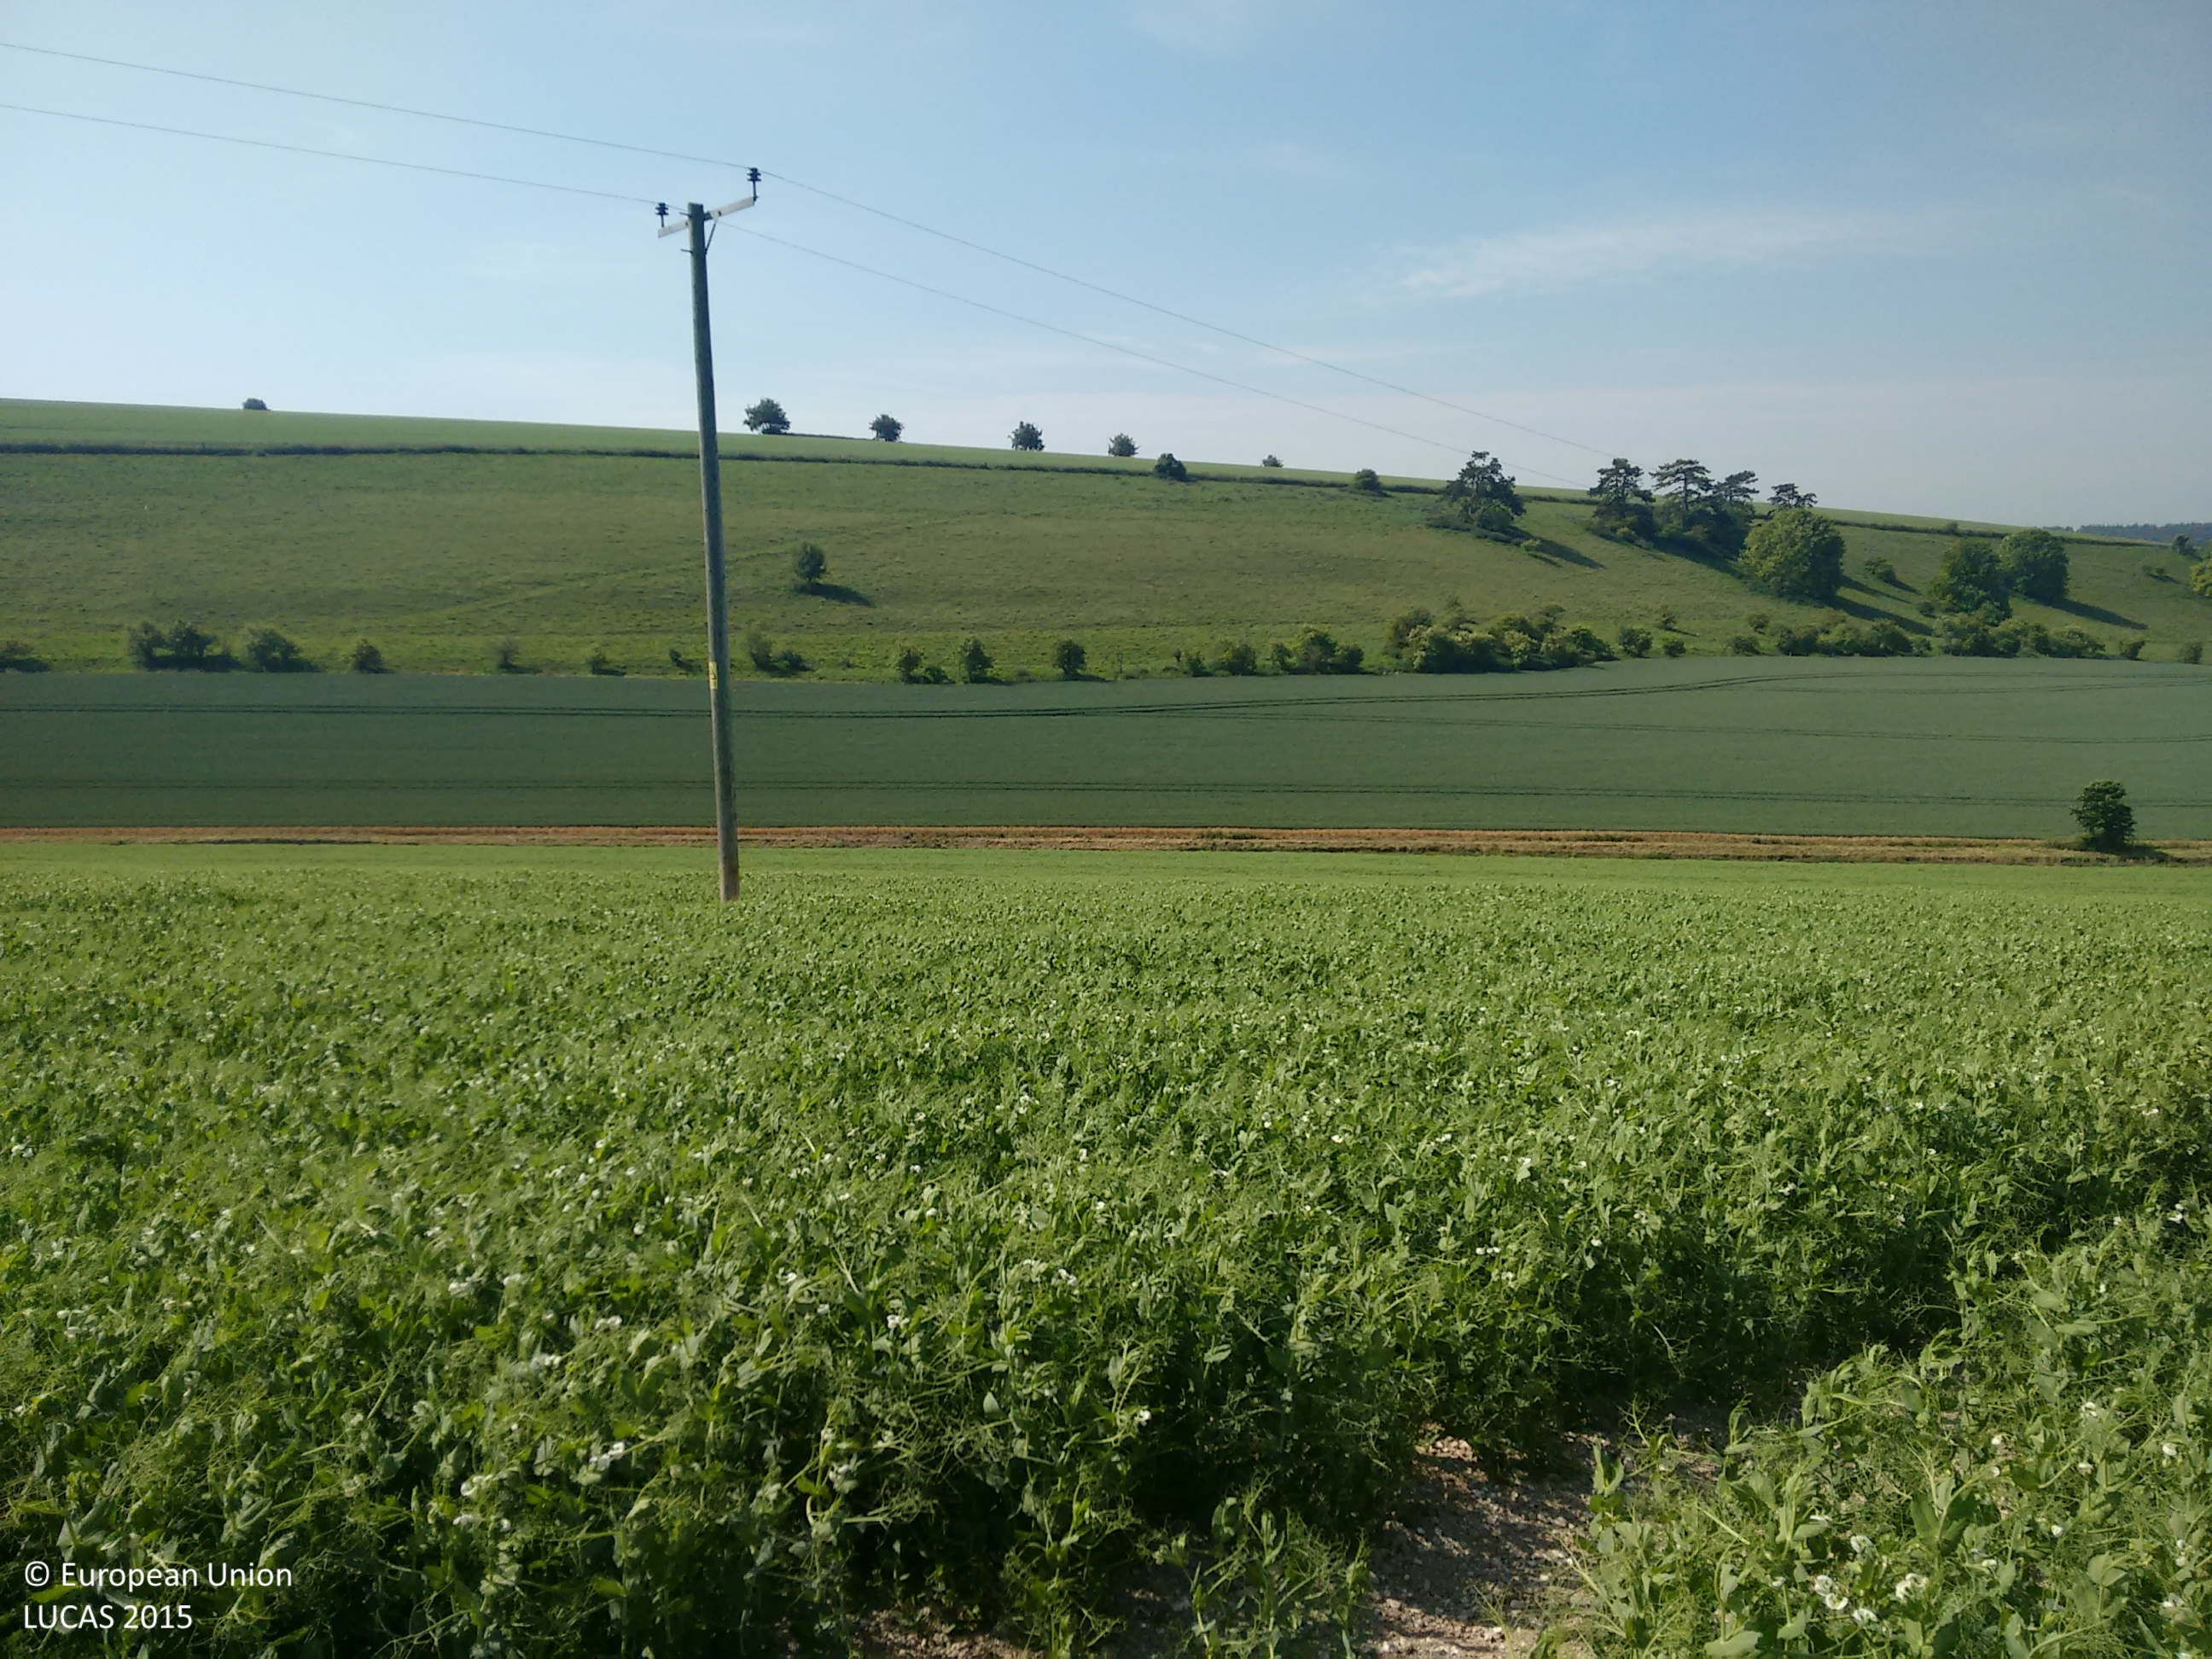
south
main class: Cropland
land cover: Dry pulses
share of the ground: > 75 %
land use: Agriculture (excluding fallow land and kitchen gardens)
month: June
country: GB
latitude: 51.1247
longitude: -1.8728
